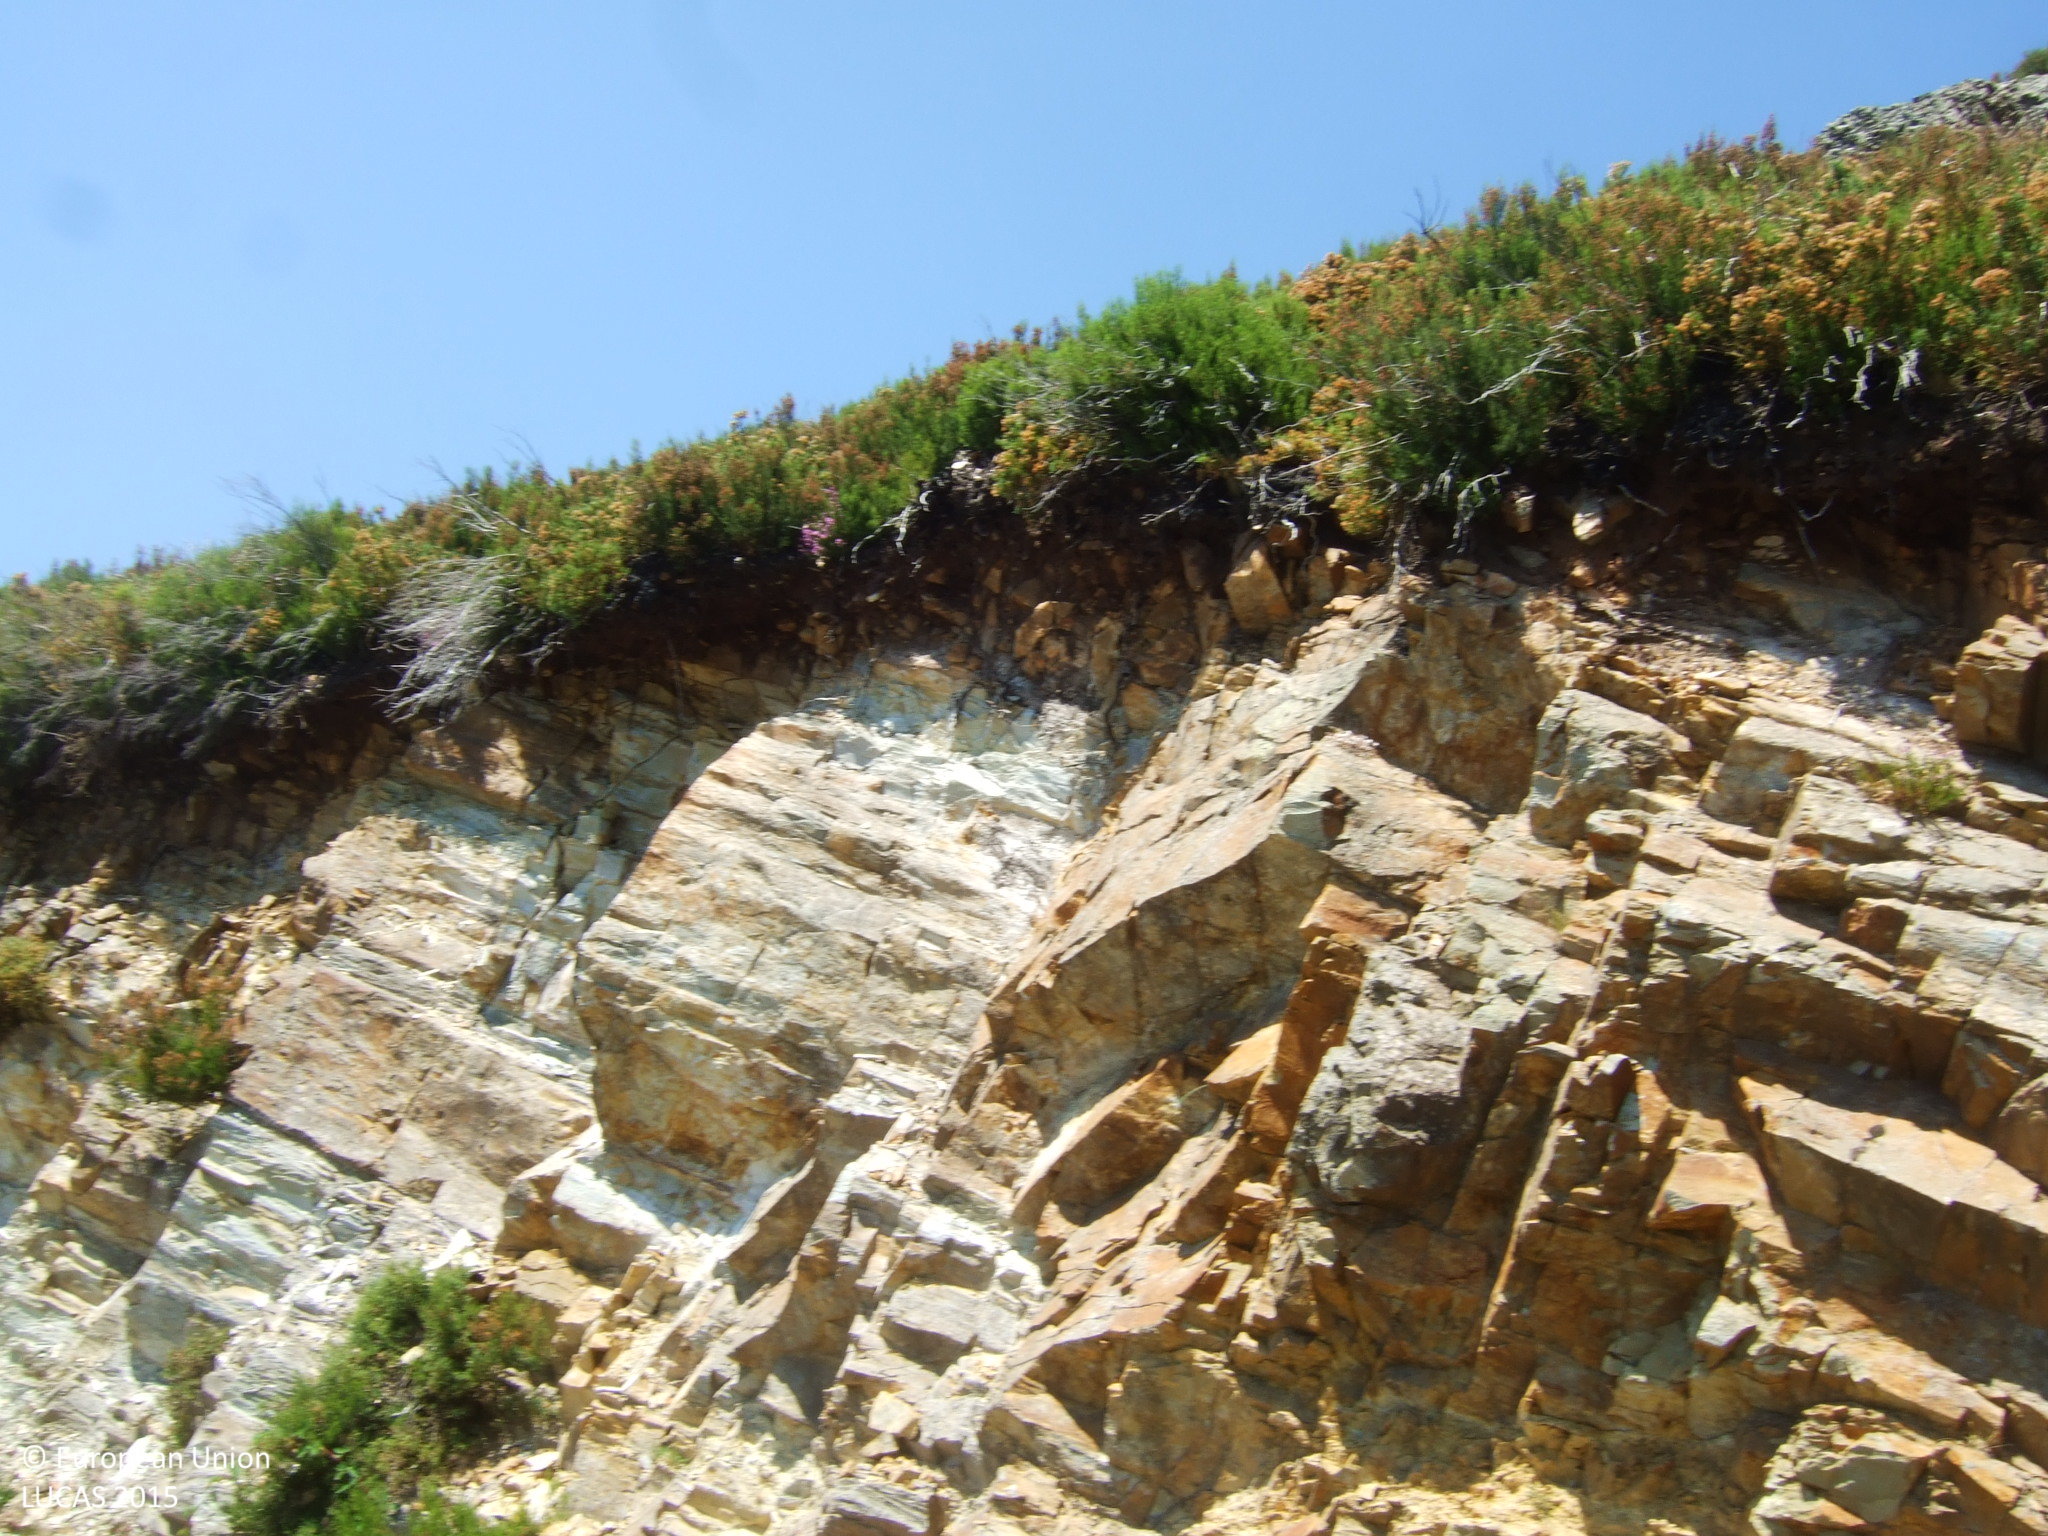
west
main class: Woodland
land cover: Broadleaved woodland
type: acidophilous oak and oak-birch forest
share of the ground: 25 - 50 %
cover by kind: shrubs 75 %, broadleaved forest trees 25 %
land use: Semi-natural and natural areas not in use
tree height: < 5 m
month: June
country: ES
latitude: 42.8542
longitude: -6.9347
